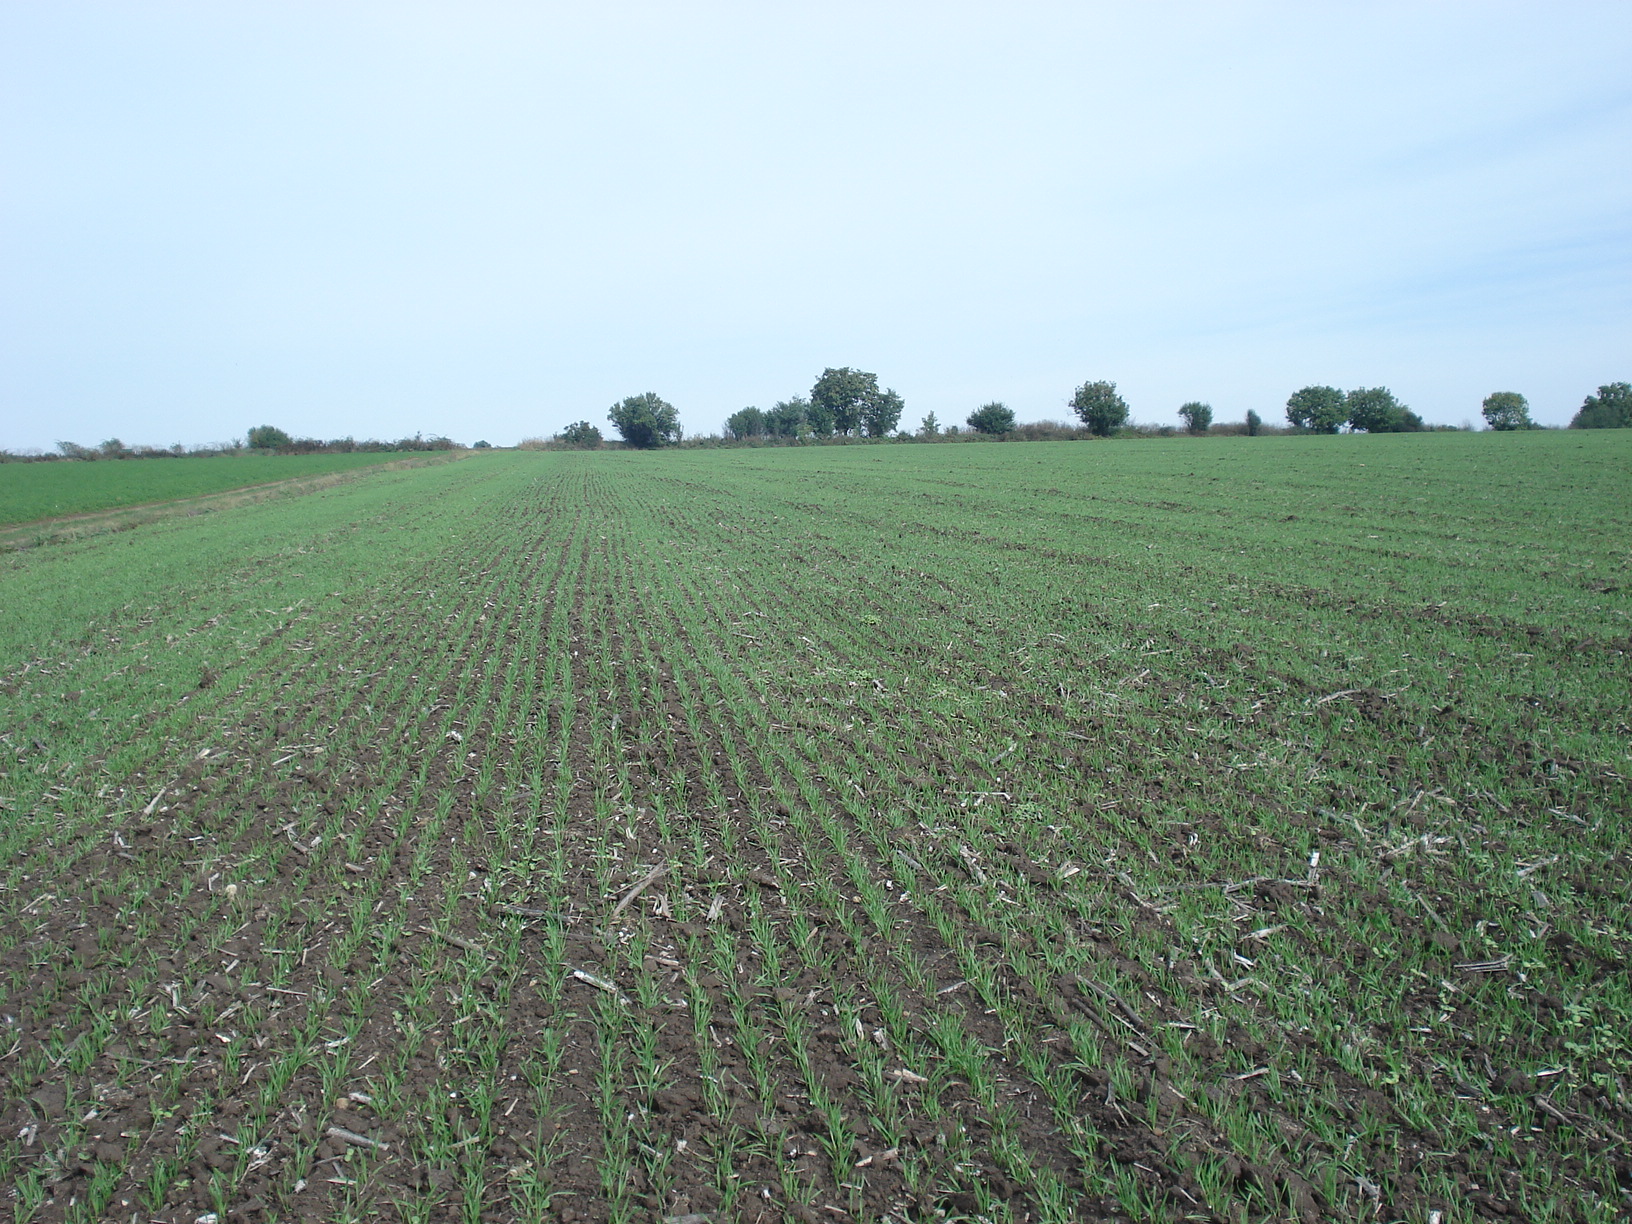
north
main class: Cropland
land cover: Common wheat
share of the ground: 25 - 50 %
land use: Agriculture (excluding fallow land and kitchen gardens)
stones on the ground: < 10 %
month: October
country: BG
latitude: 43.3064
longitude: 25.3761
